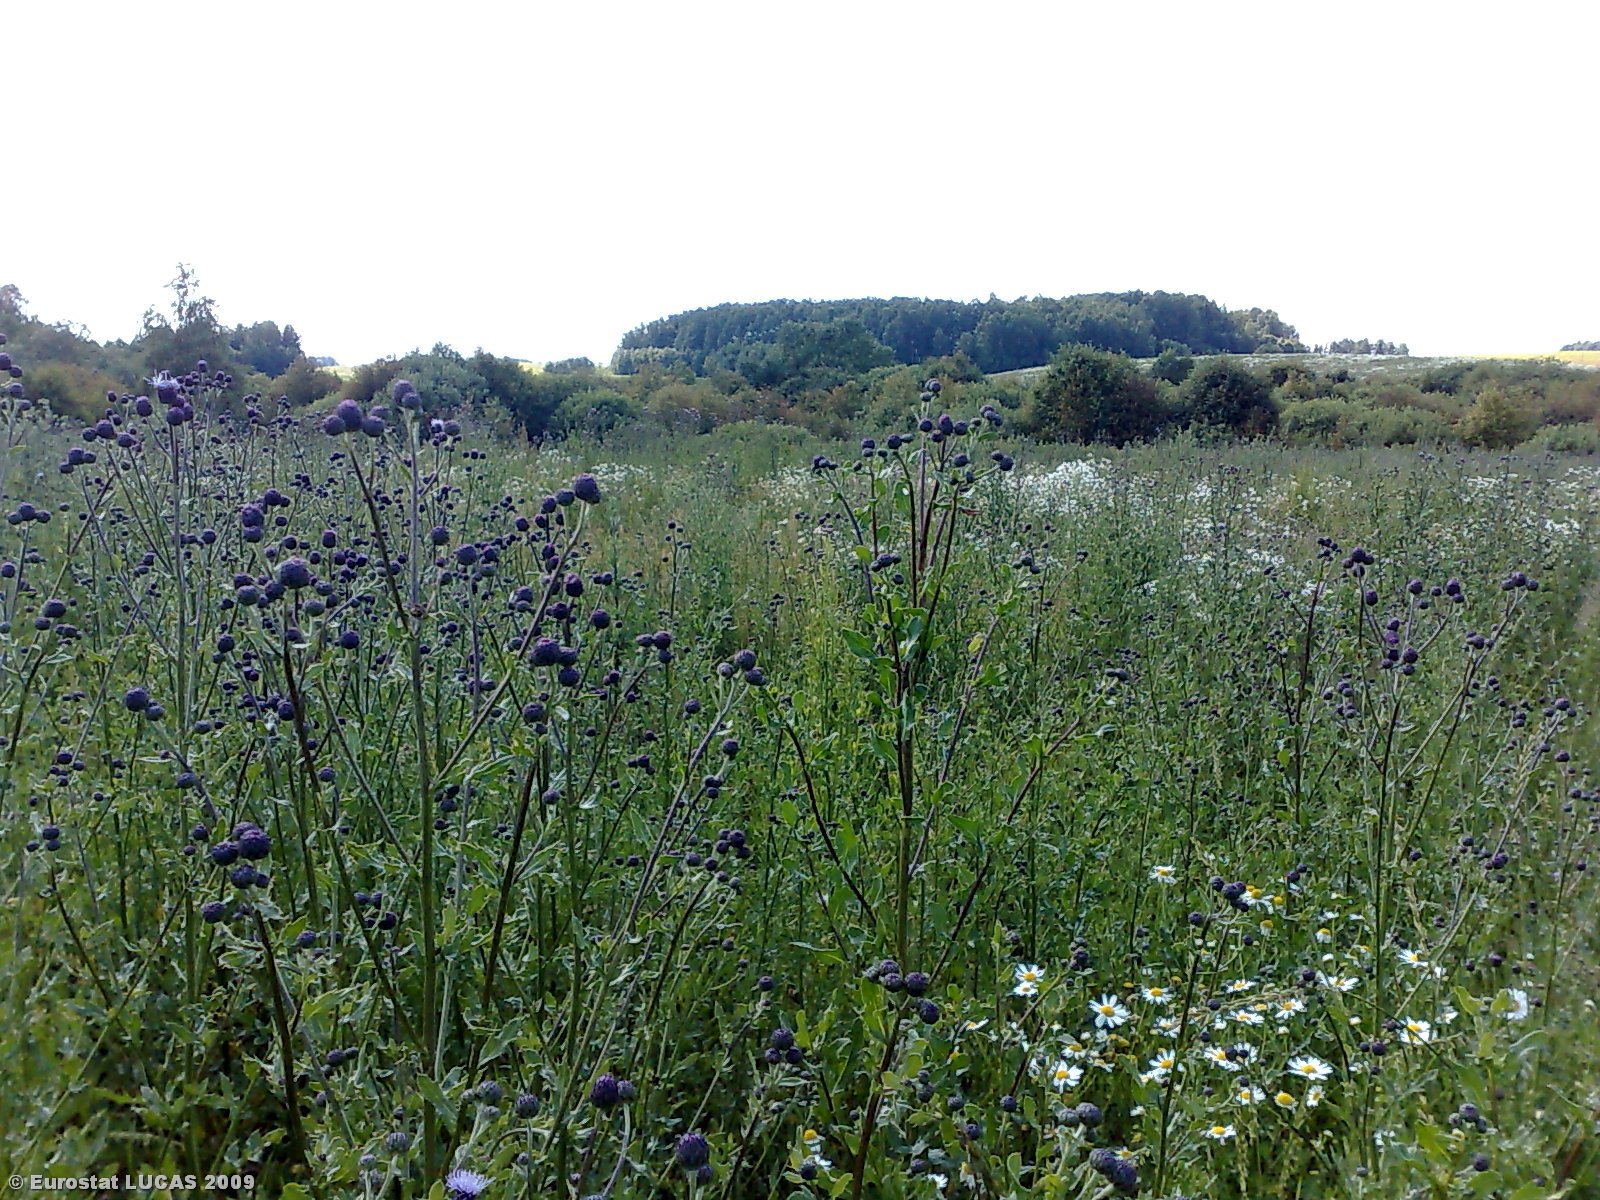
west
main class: Grassland
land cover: Grassland without tree/shrub cover
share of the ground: > 75 %
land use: Agriculture (excluding fallow land and kitchen gardens)
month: July
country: LT
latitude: 55.5120
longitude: 22.7494
